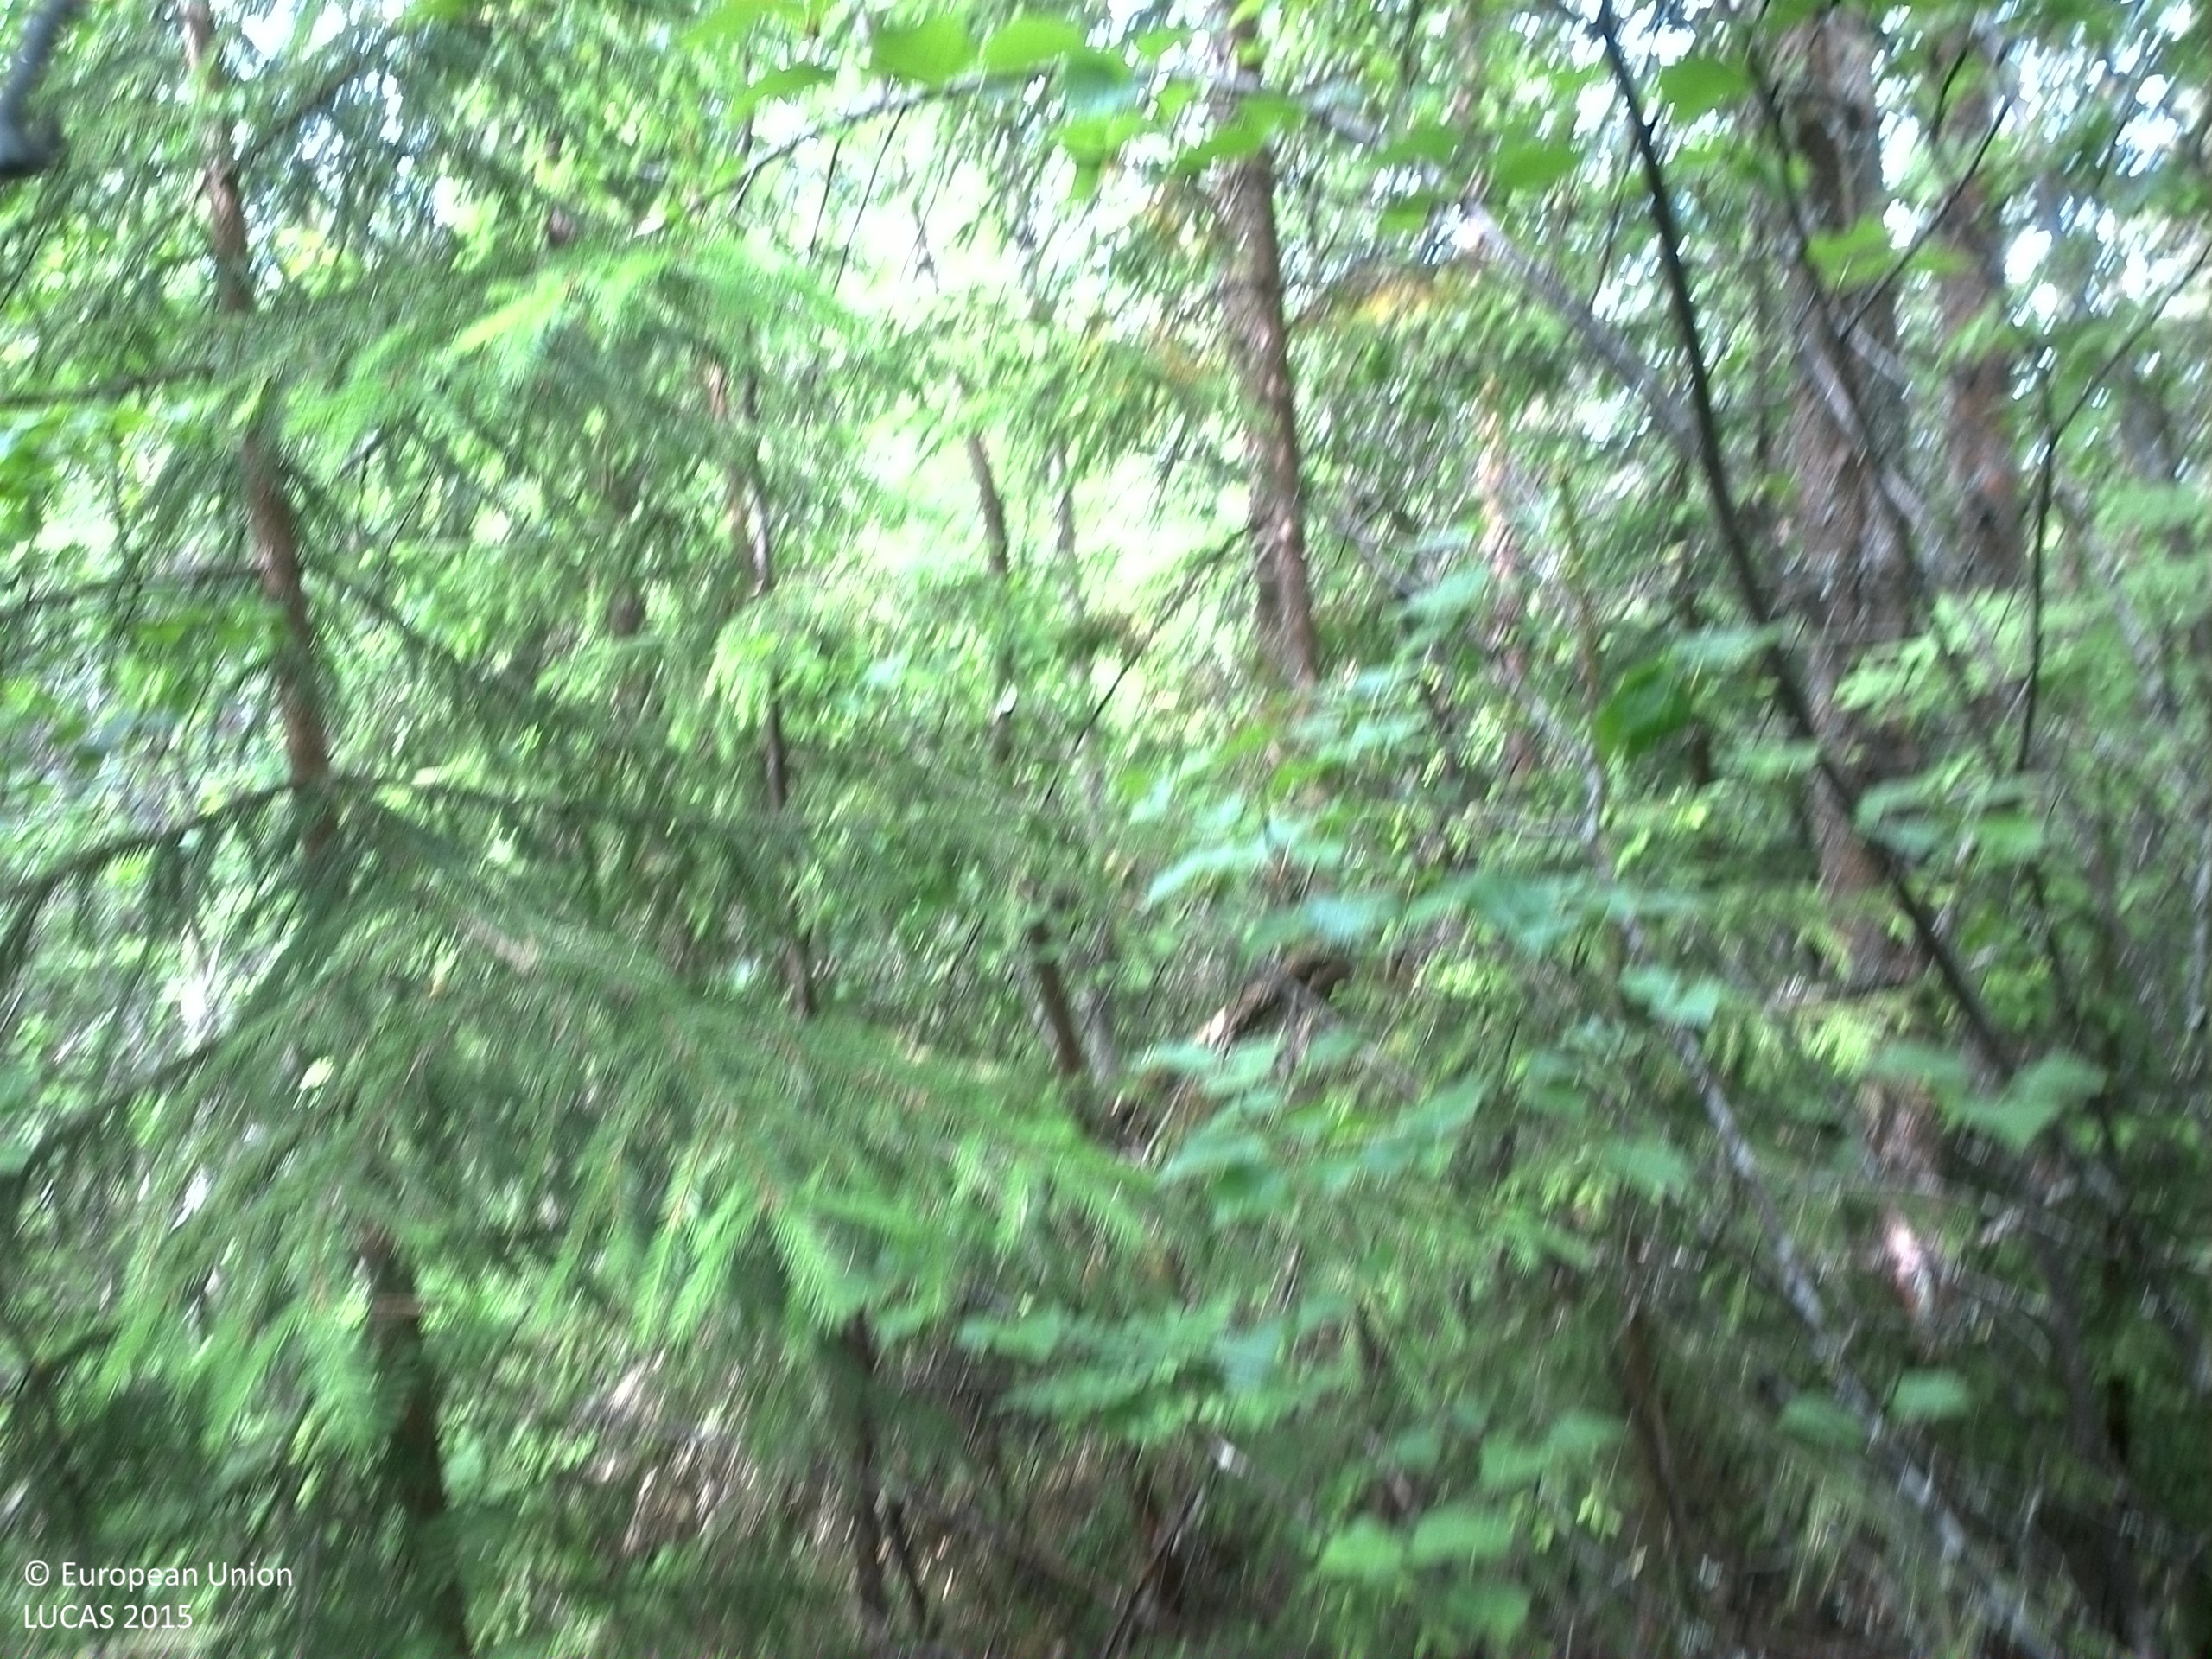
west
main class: Woodland
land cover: Spruce dominated mixed woodland
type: boreal forest
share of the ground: > 75 %
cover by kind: coniferous forest trees 60 %, broadleaved forest trees 20 %, shrubs 20 %
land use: Forestry
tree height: > 5 m
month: June
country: SE
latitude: 62.8683
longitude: 17.7028
